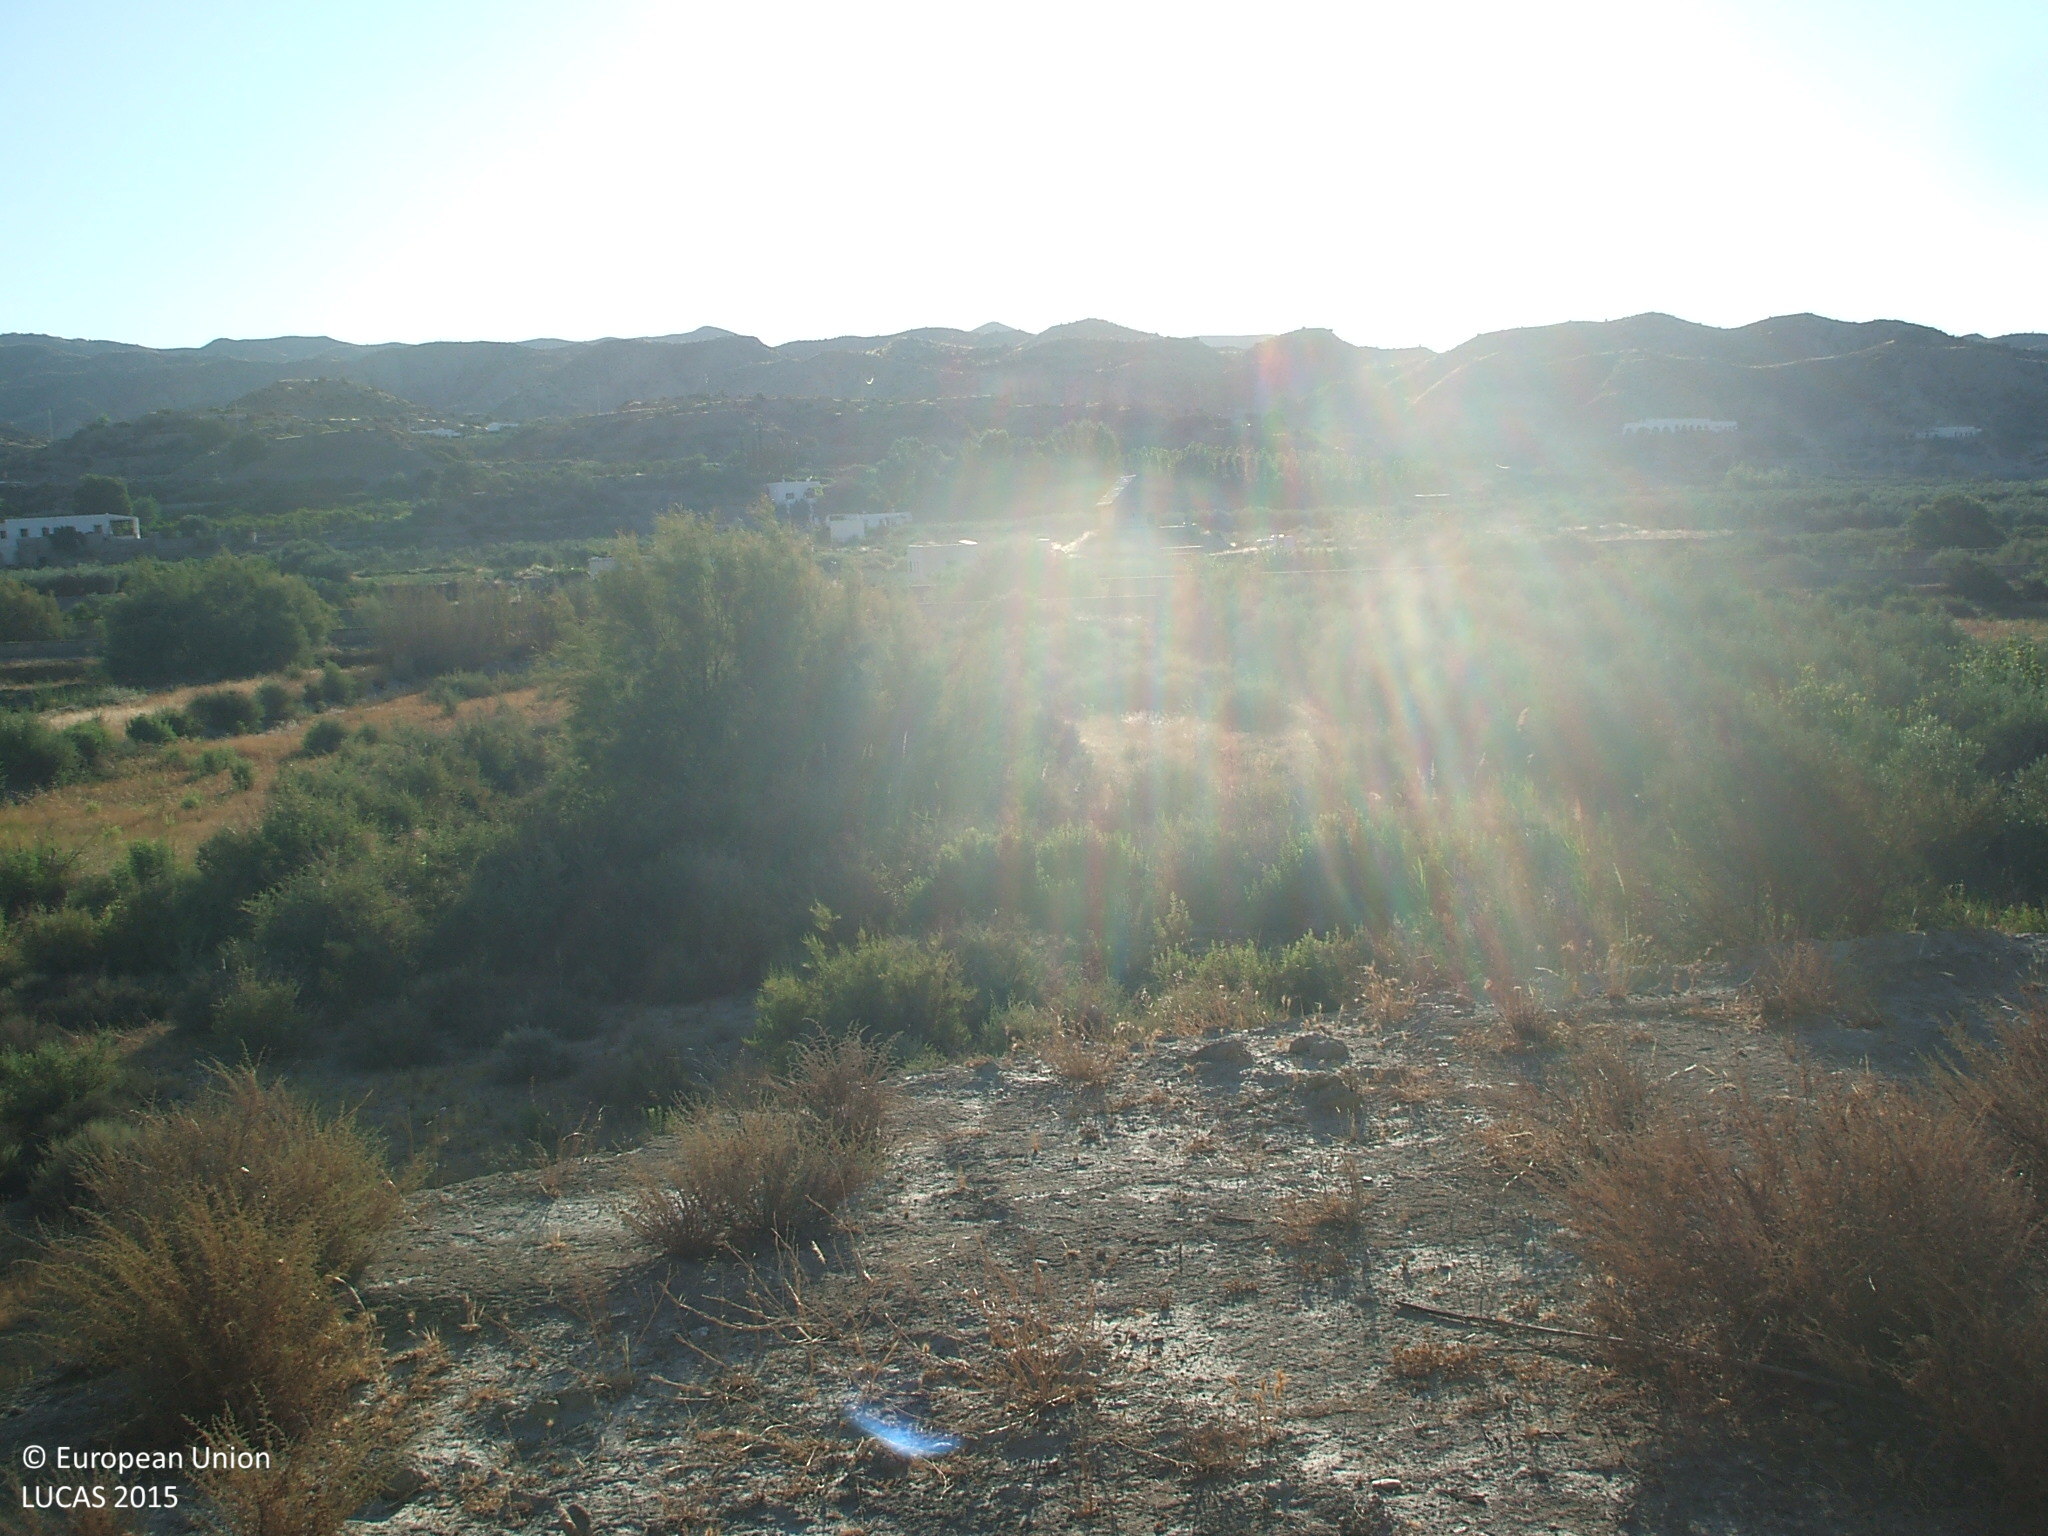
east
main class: Shrubland
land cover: Shrubland without tree cover
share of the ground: 50 - 75 %
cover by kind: shrubs 60 %, consolidated bare surface 40 %
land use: Semi-natural and natural areas not in use
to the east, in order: Shrubland without tree cover; Ditches and canals; Grassland without tree/shrub cover; Other fresh vegetables; Olive groves; Paved roads, cycling and walking lanes; Dry stone walls; Inland fresh running water; Shrubland without tree cover; Dry stone walls; Paved roads, cycling and walking lanes; Shrubland without tree cover; Olive groves
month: June
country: ES
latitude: 36.9979
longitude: -2.5972
